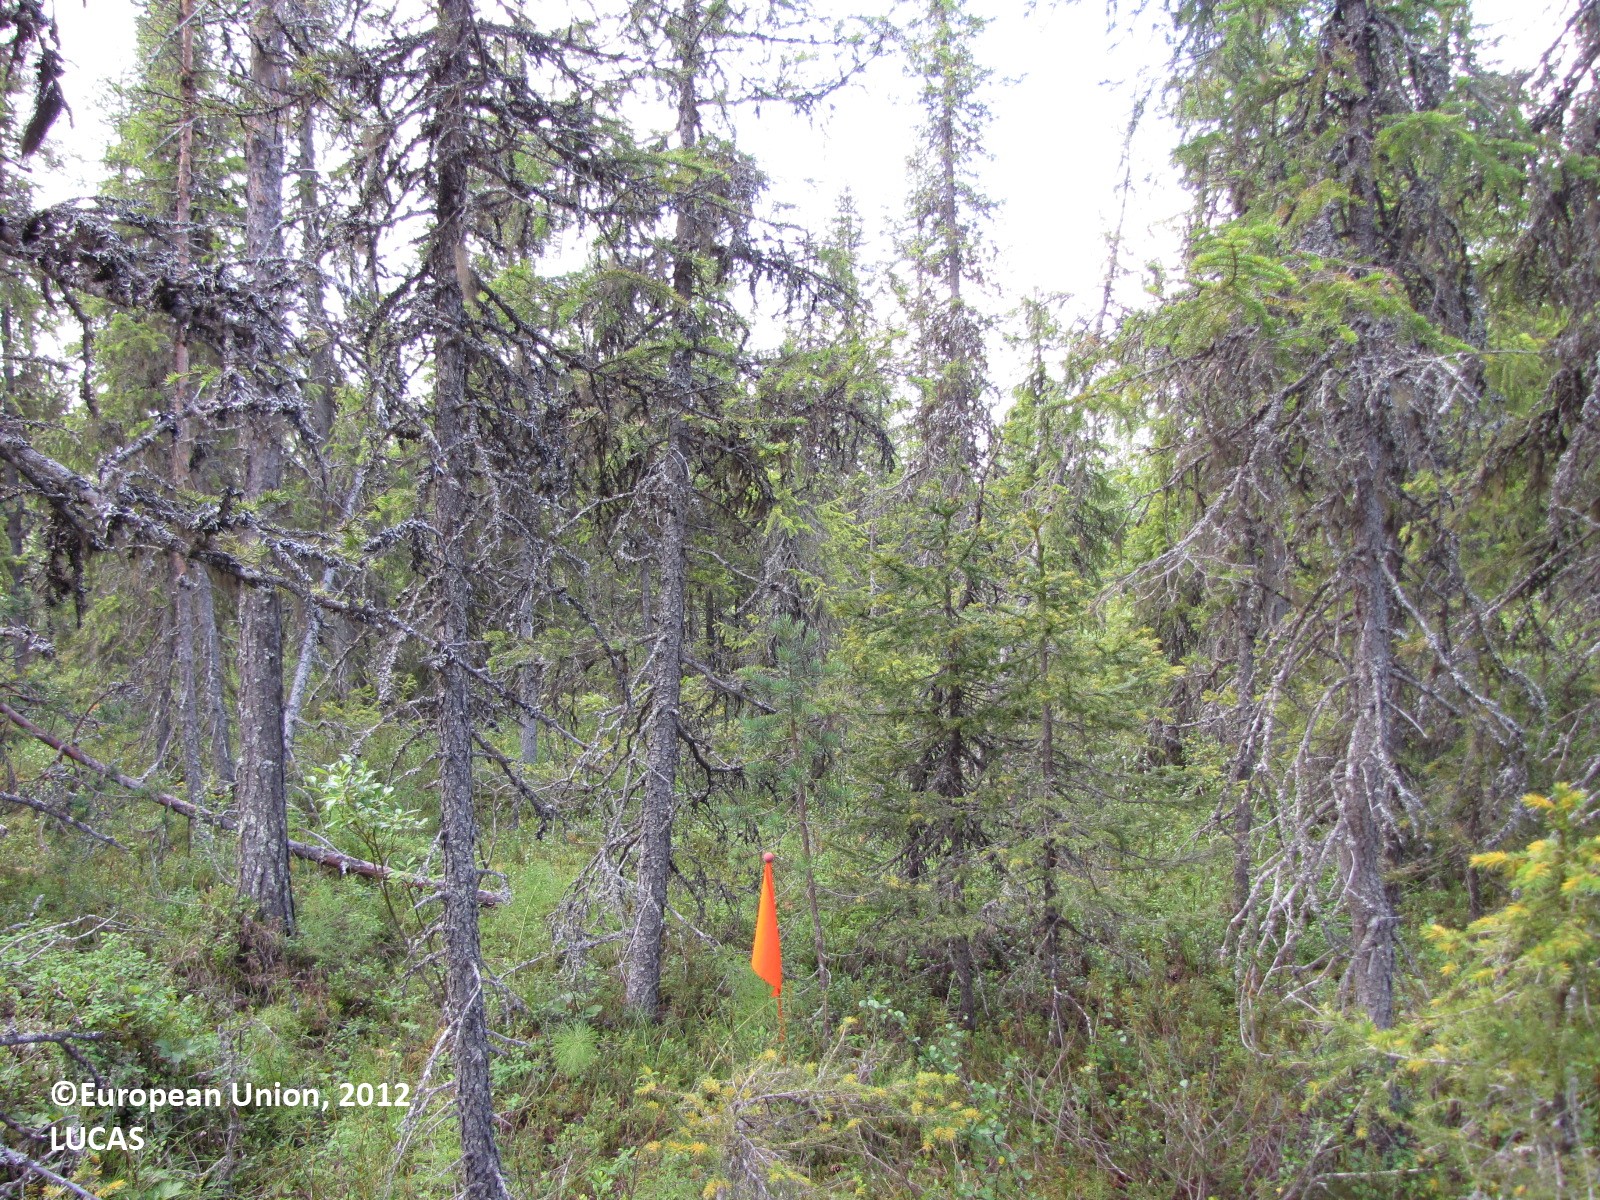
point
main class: Woodland
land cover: Spruce dominated coniferous woodland
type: boreal forest
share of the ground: 25 - 50 %
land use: Forestry
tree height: > 5 m
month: August
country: FI
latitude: 66.8599
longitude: 24.5667
